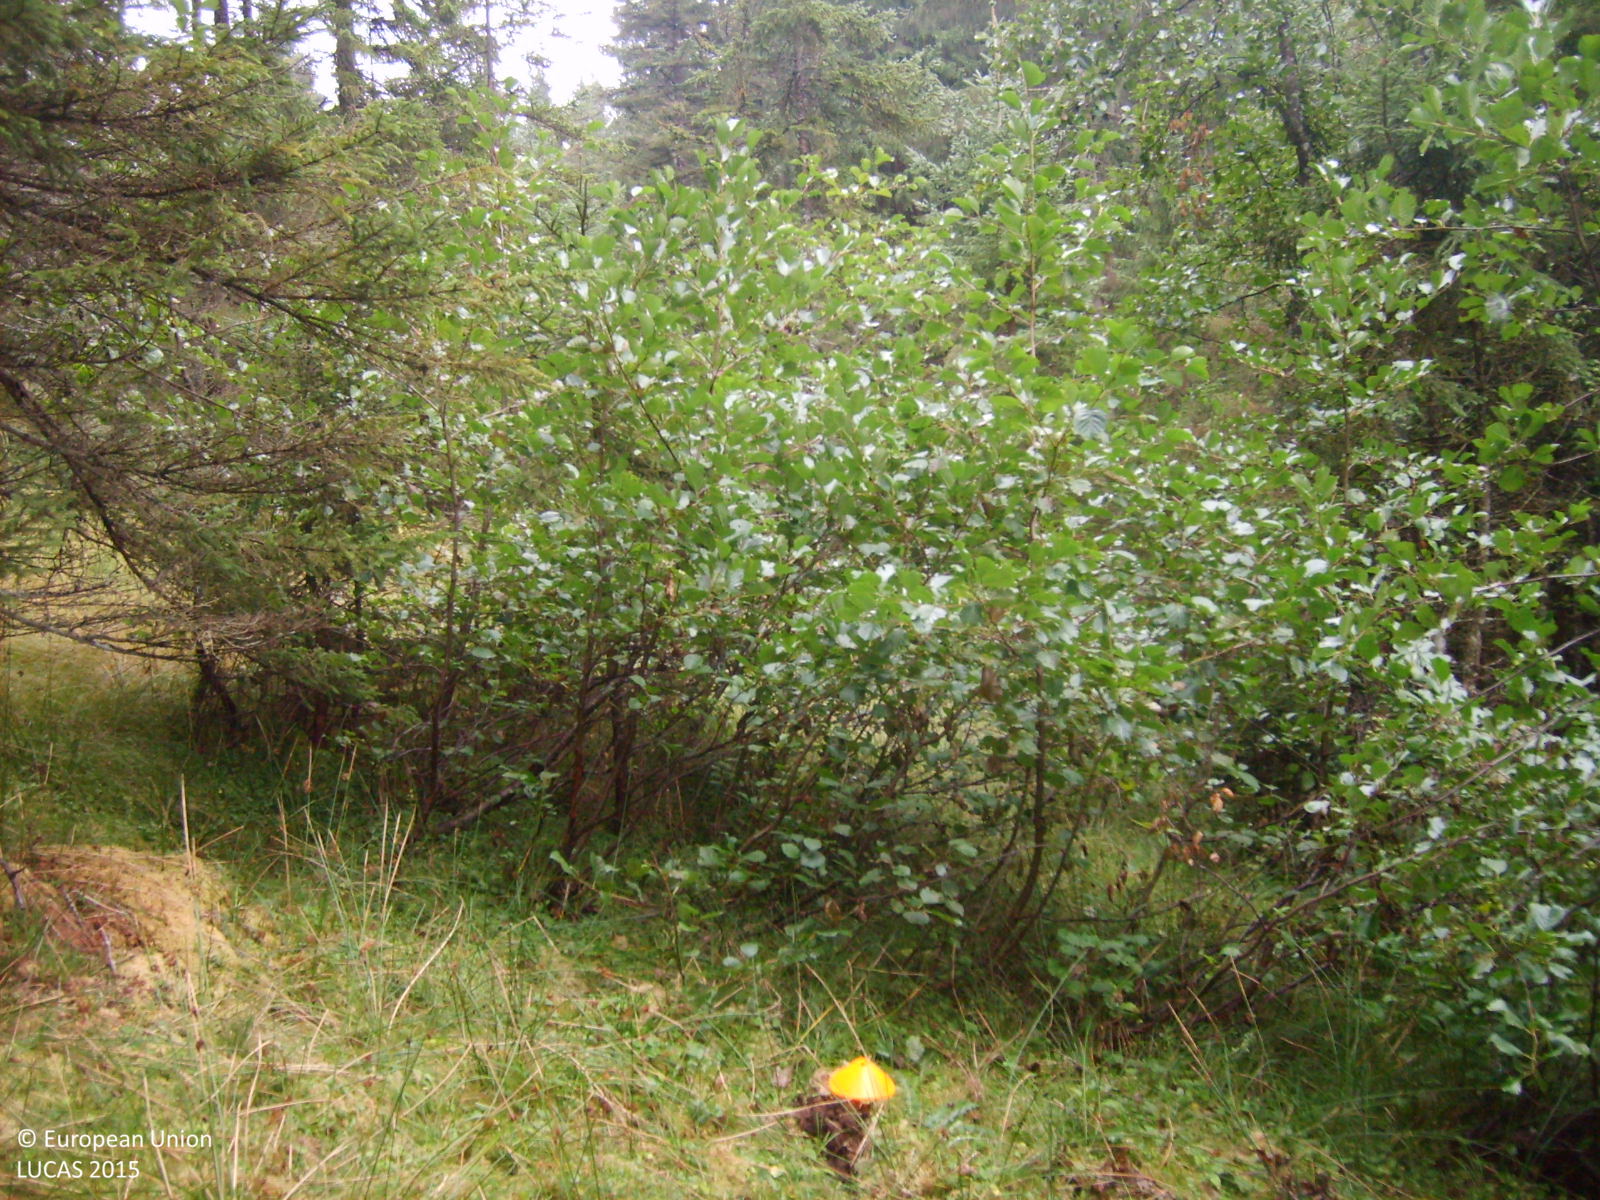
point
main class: Woodland
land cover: Spruce dominated coniferous woodland
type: alpine coniferous forest
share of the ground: > 75 %
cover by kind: coniferous forest trees 70 %, broadleaved forest trees 10 %, shrubs 10 %, herbaceous plants 10 %
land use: Forestry
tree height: > 5 m
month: September
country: AT
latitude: 47.4847
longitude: 13.4622
